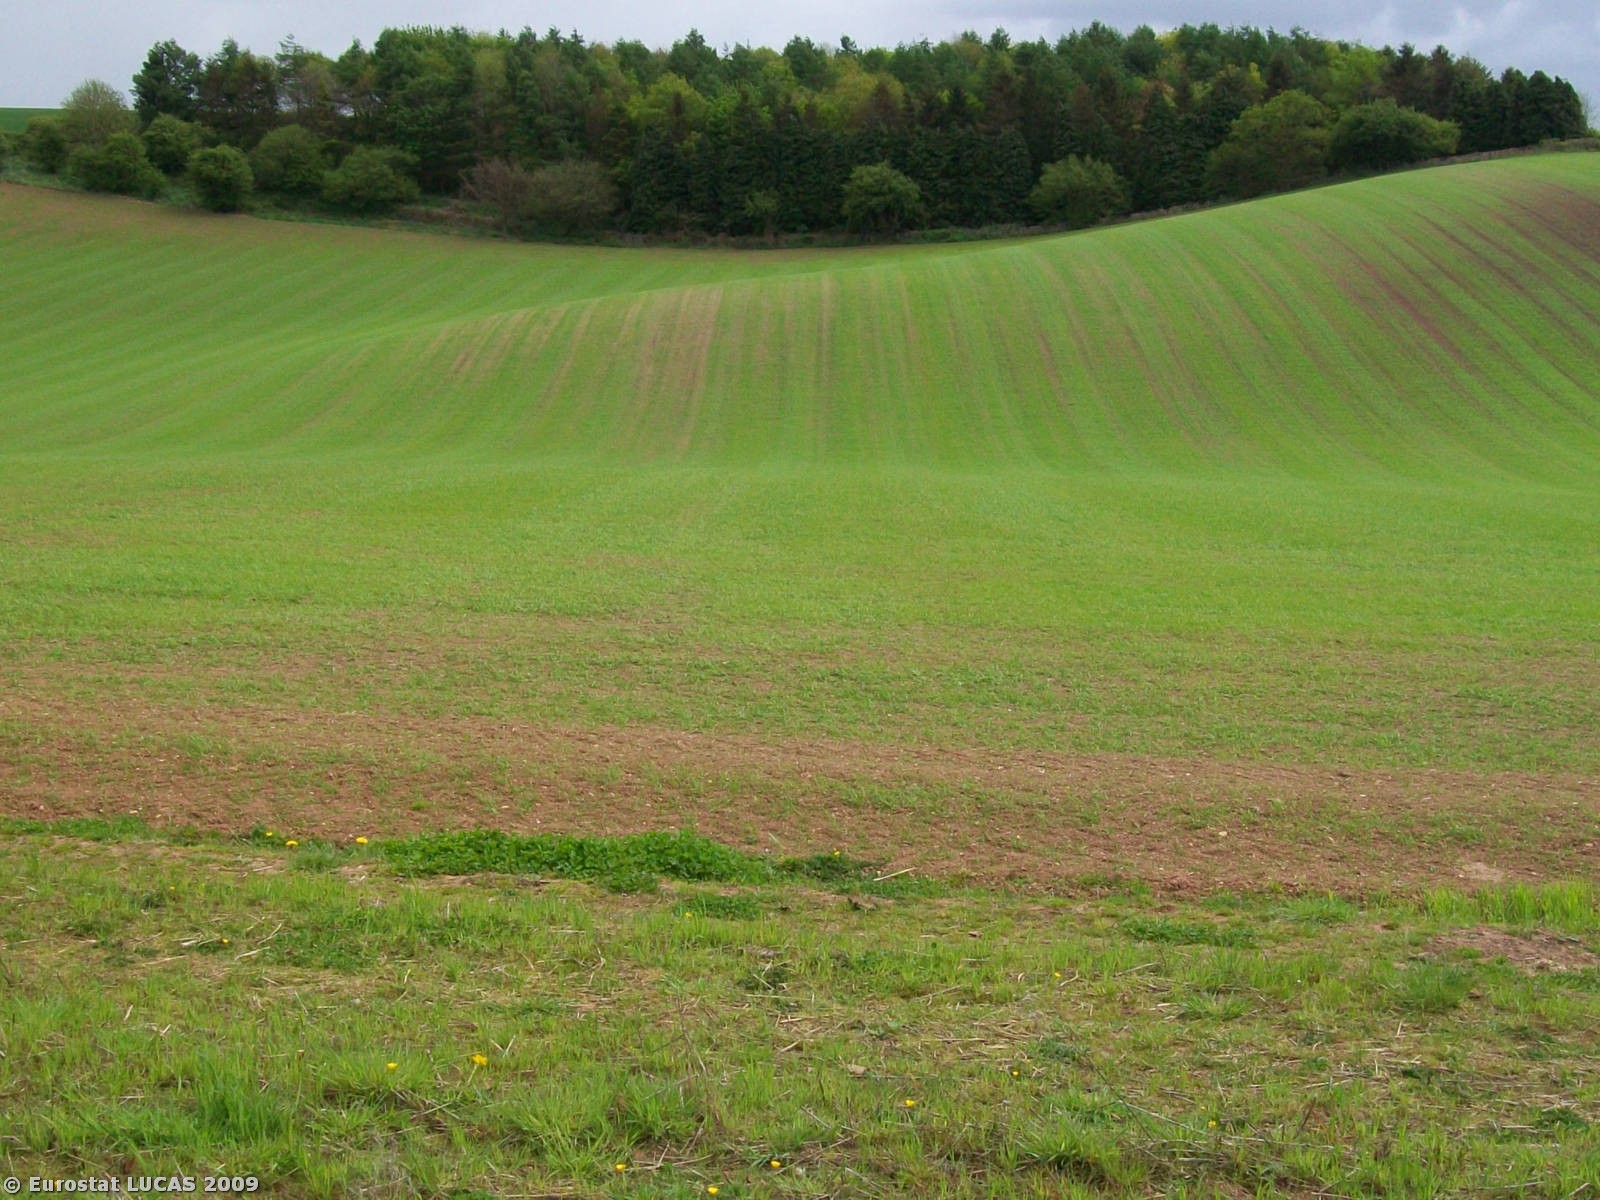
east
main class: Grassland
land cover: Grassland without tree/shrub cover
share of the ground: > 75 %
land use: Agriculture (excluding fallow land and kitchen gardens)
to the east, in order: Grassland without tree/shrub cover; Barley; Grass margins; Broadleaved woodland
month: May
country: GB
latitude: 52.4242
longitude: -2.4923
